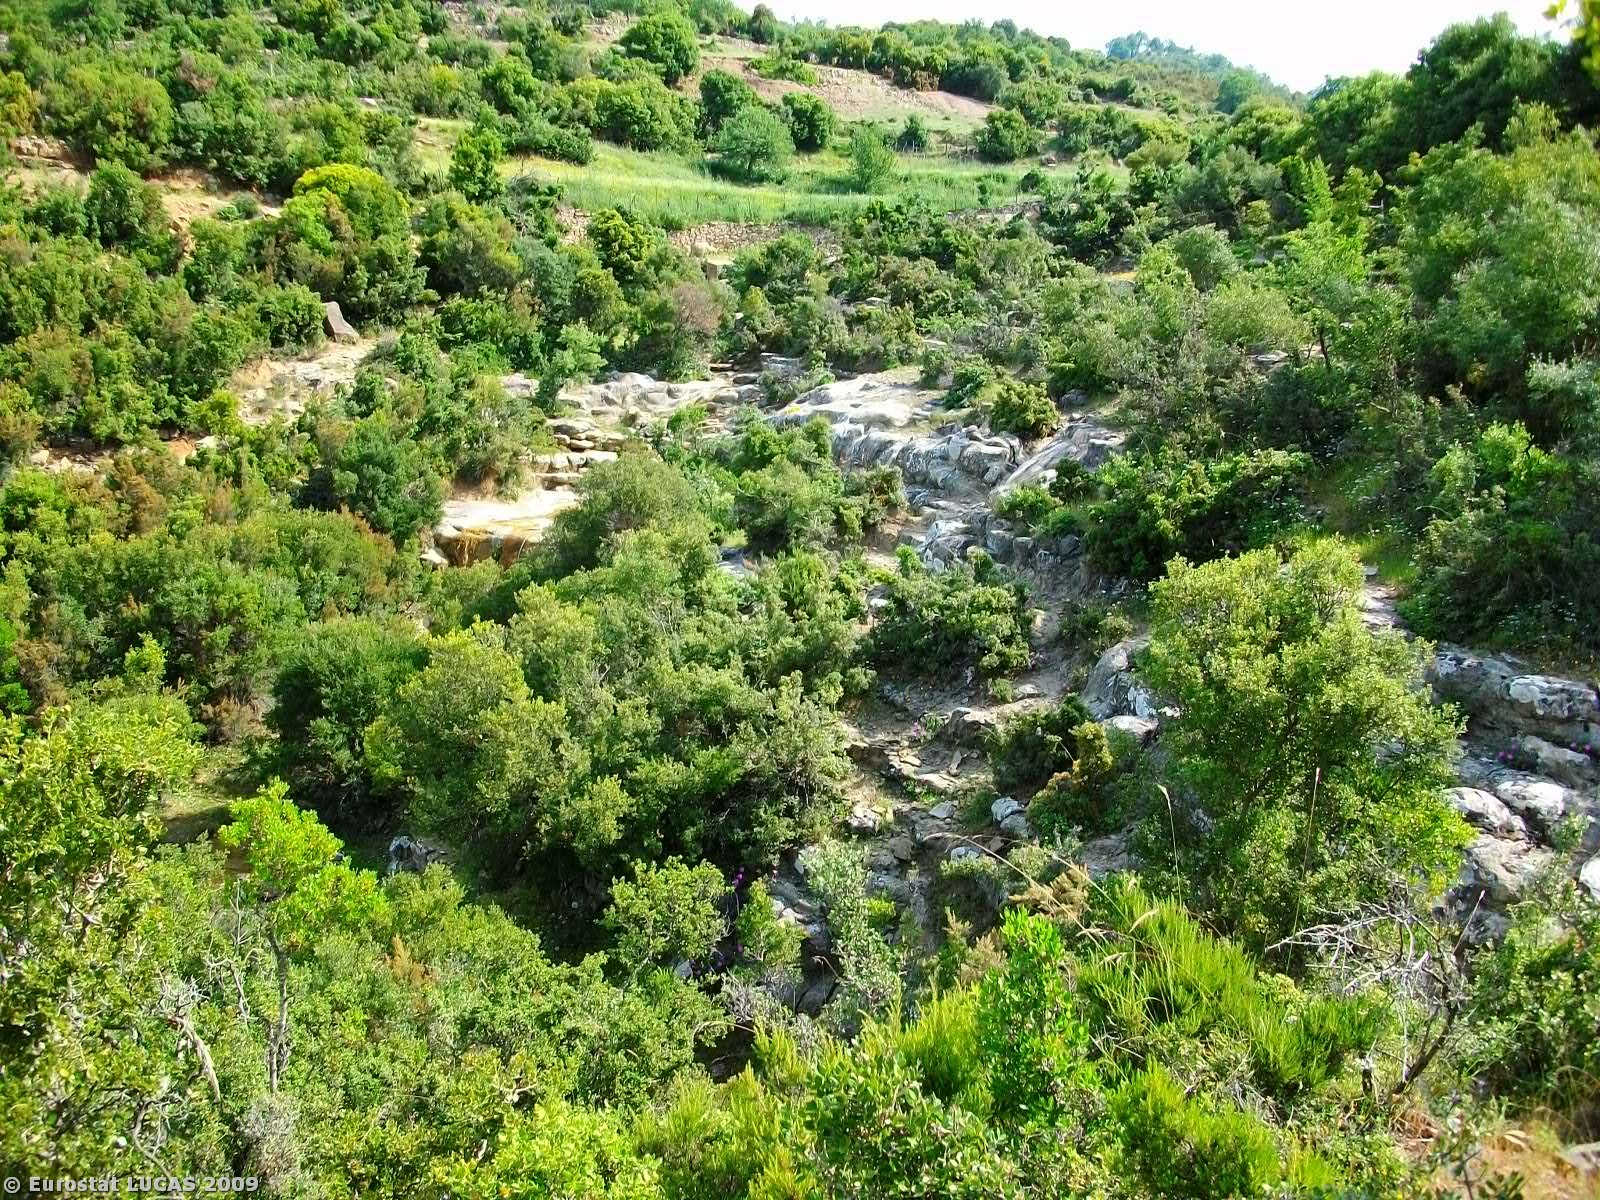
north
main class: Shrubland
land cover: Shrubland with sparse tree cover
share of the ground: > 75 %
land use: Unused
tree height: > 5 m
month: May
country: GR
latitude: 38.4658
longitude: 21.4177
